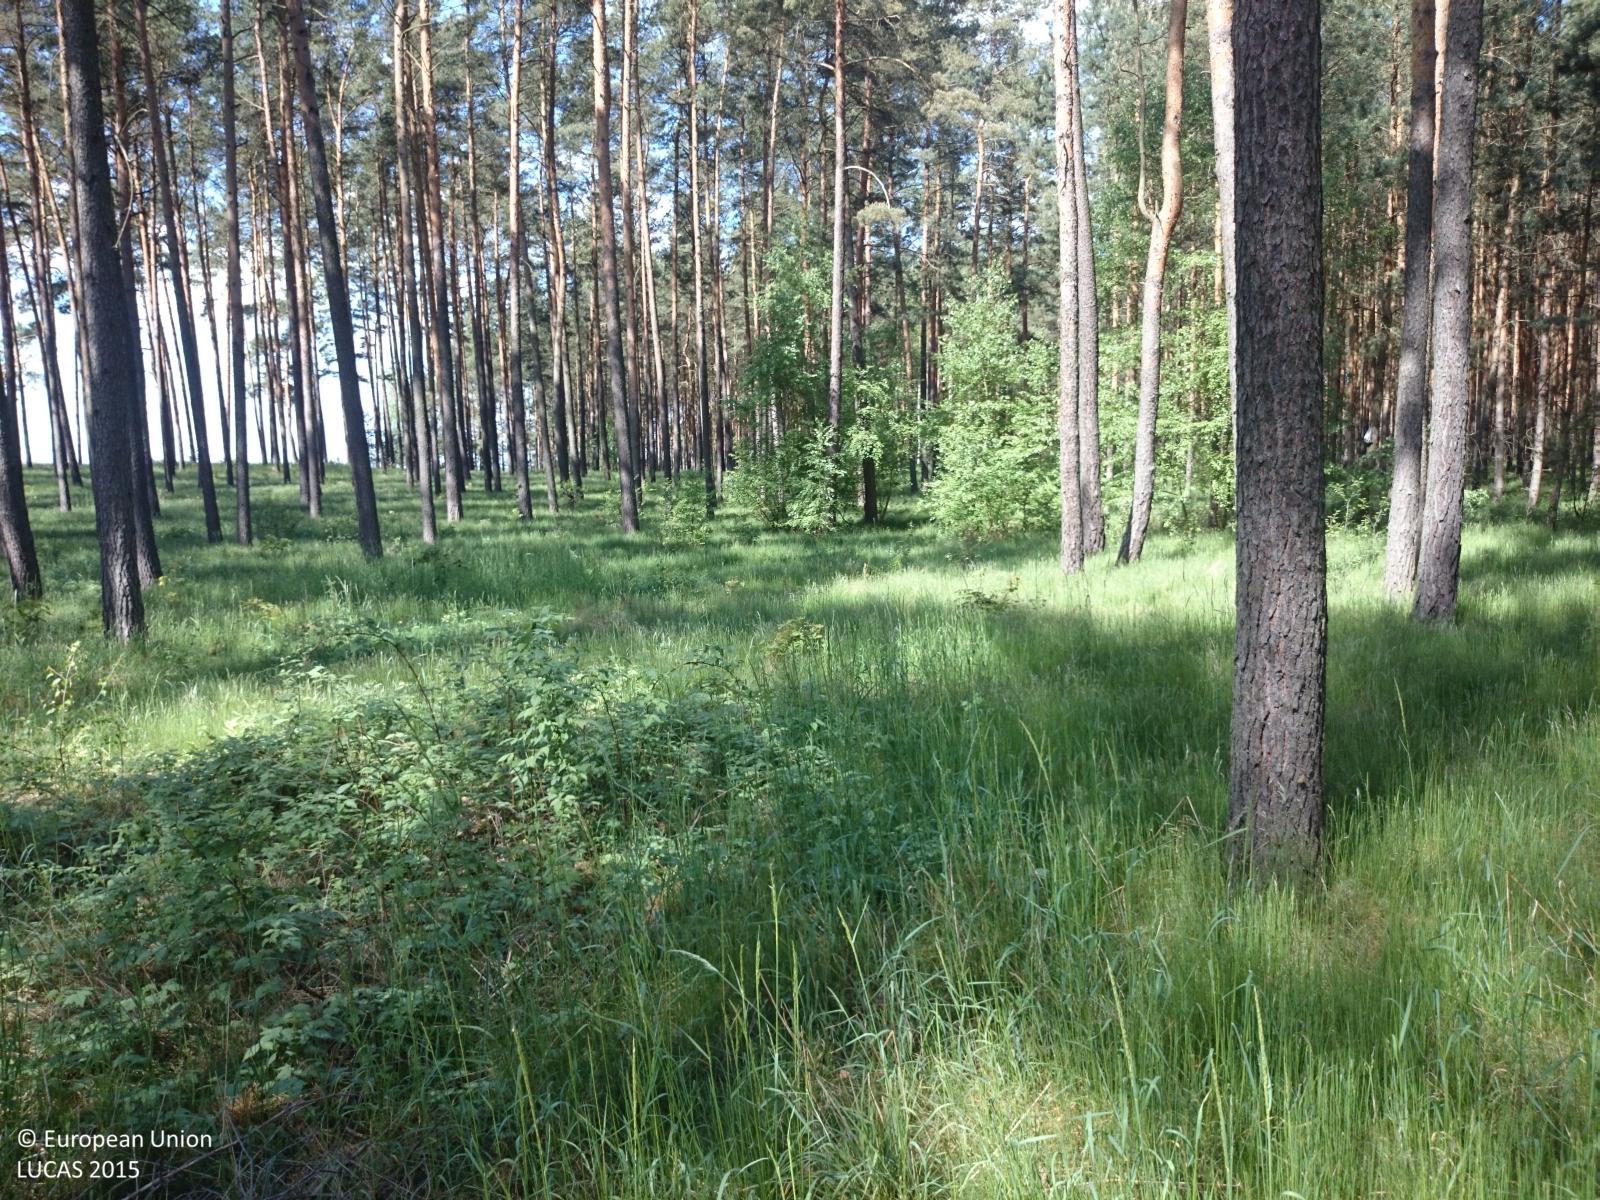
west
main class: Woodland
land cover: Pine dominated coniferous woodland
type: hemiboreal forest and nemoral coniferous forest and mixed broadleaved-coniferous forest
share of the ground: 50 - 75 %
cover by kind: coniferous forest trees 65 %, herbaceous plants 35 %
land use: Forestry
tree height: > 5 m
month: May
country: PL
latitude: 52.5313
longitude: 15.6503
